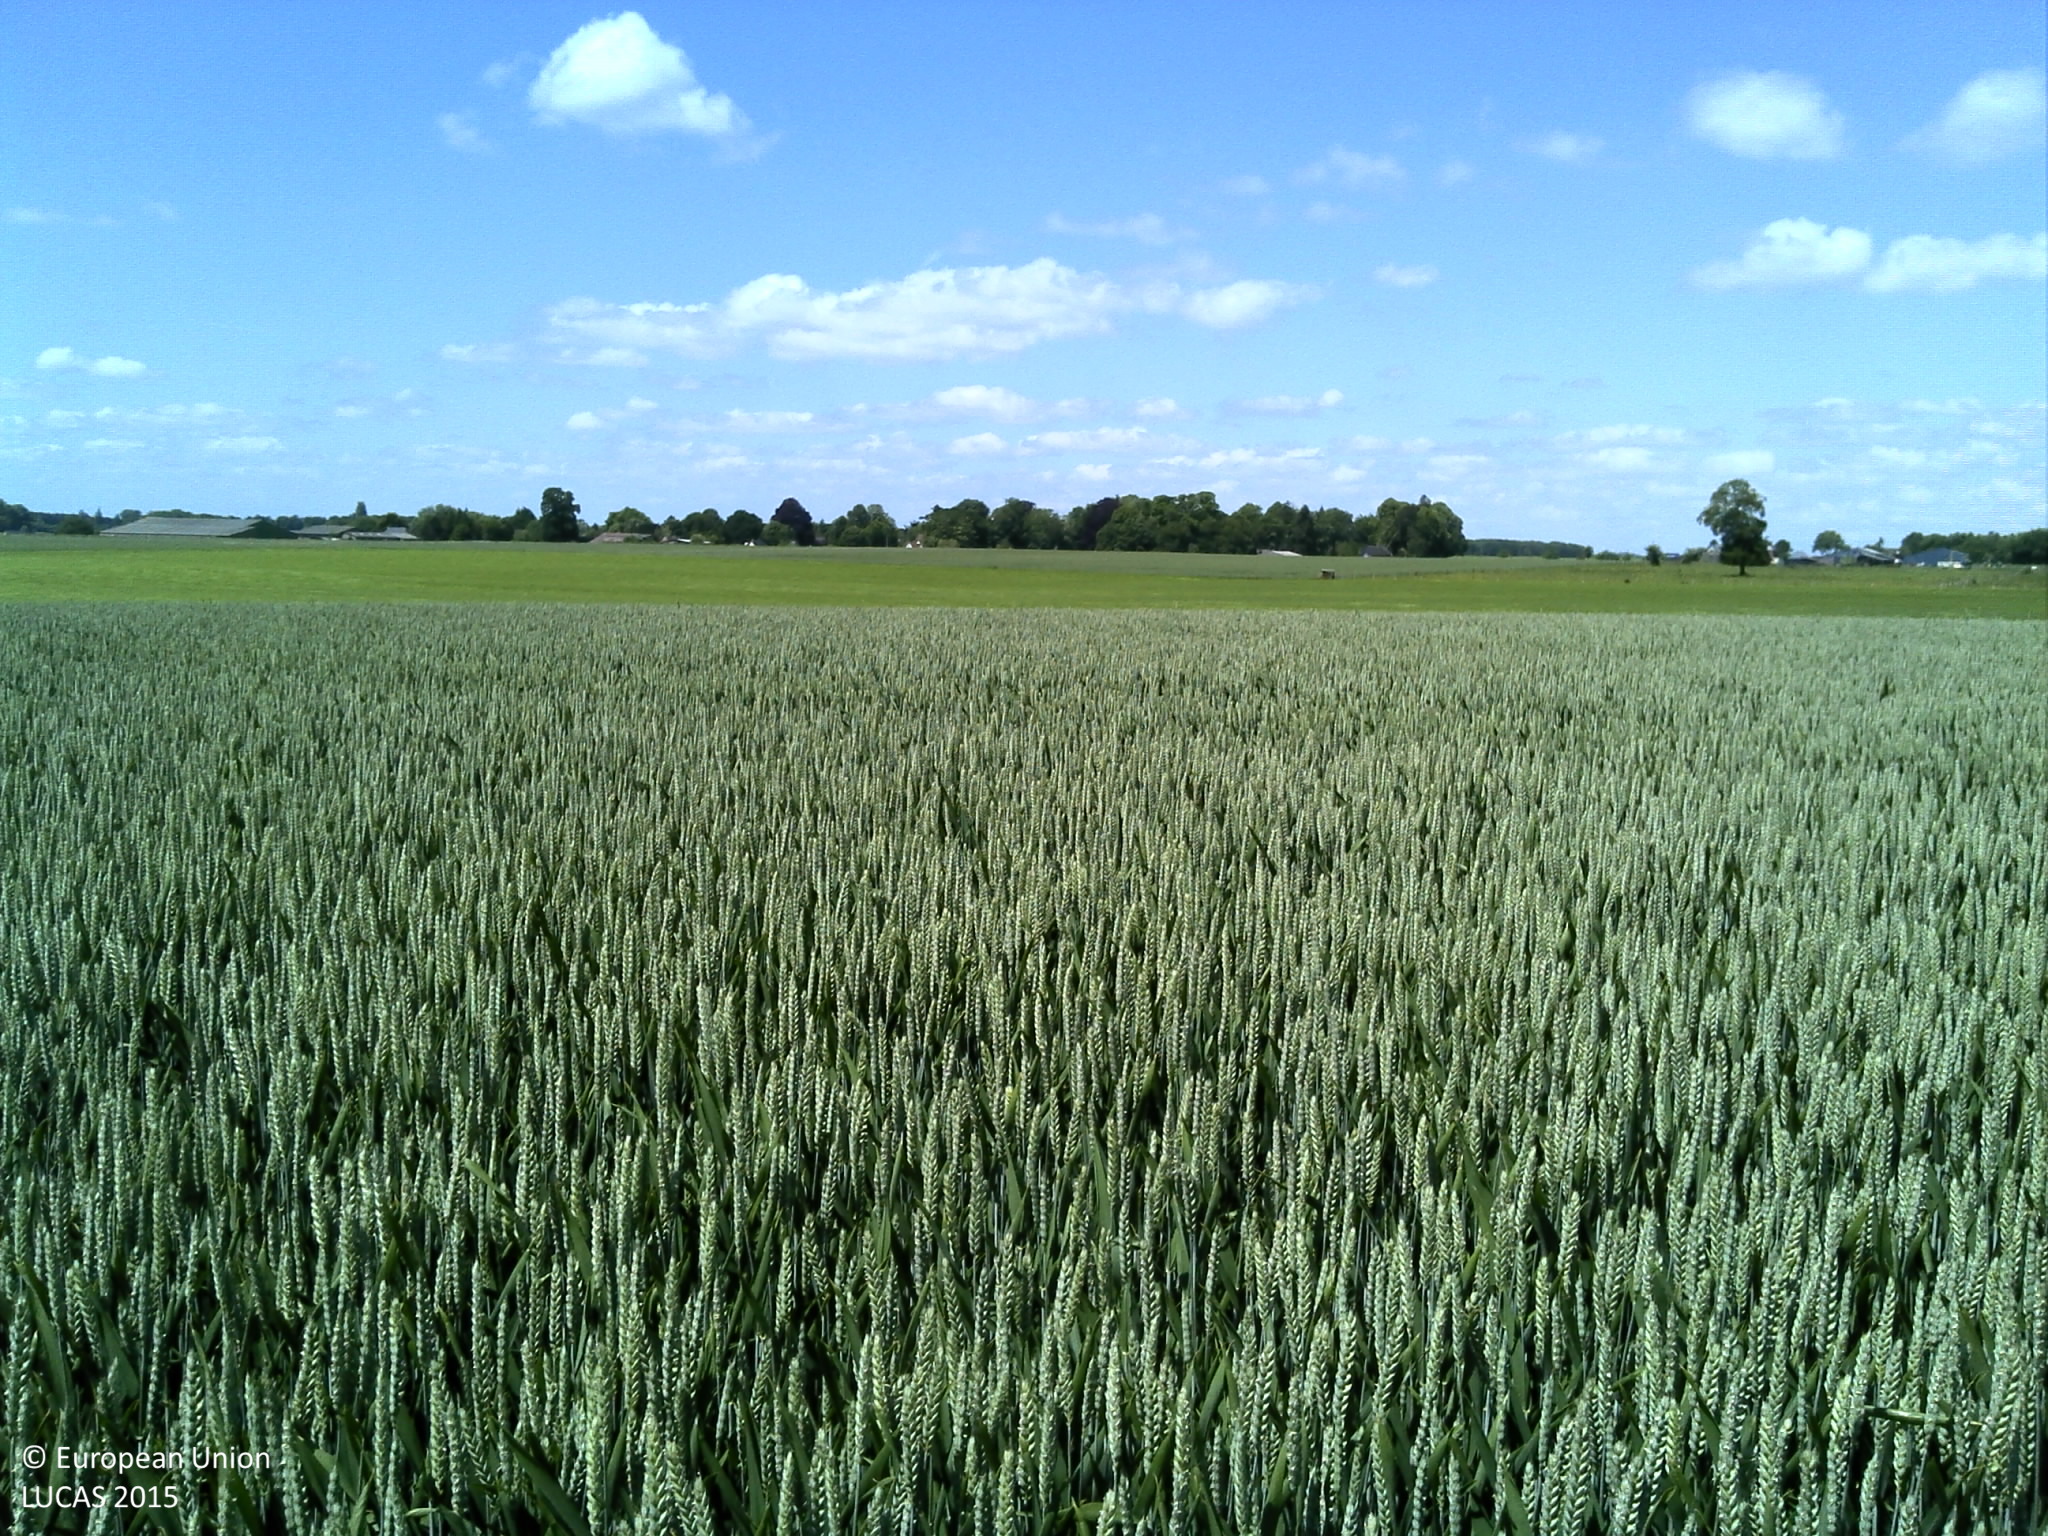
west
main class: Cropland
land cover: Common wheat
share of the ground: > 75 %
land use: Agriculture (excluding fallow land and kitchen gardens)
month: June
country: FR
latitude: 49.5141
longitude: 1.1531
